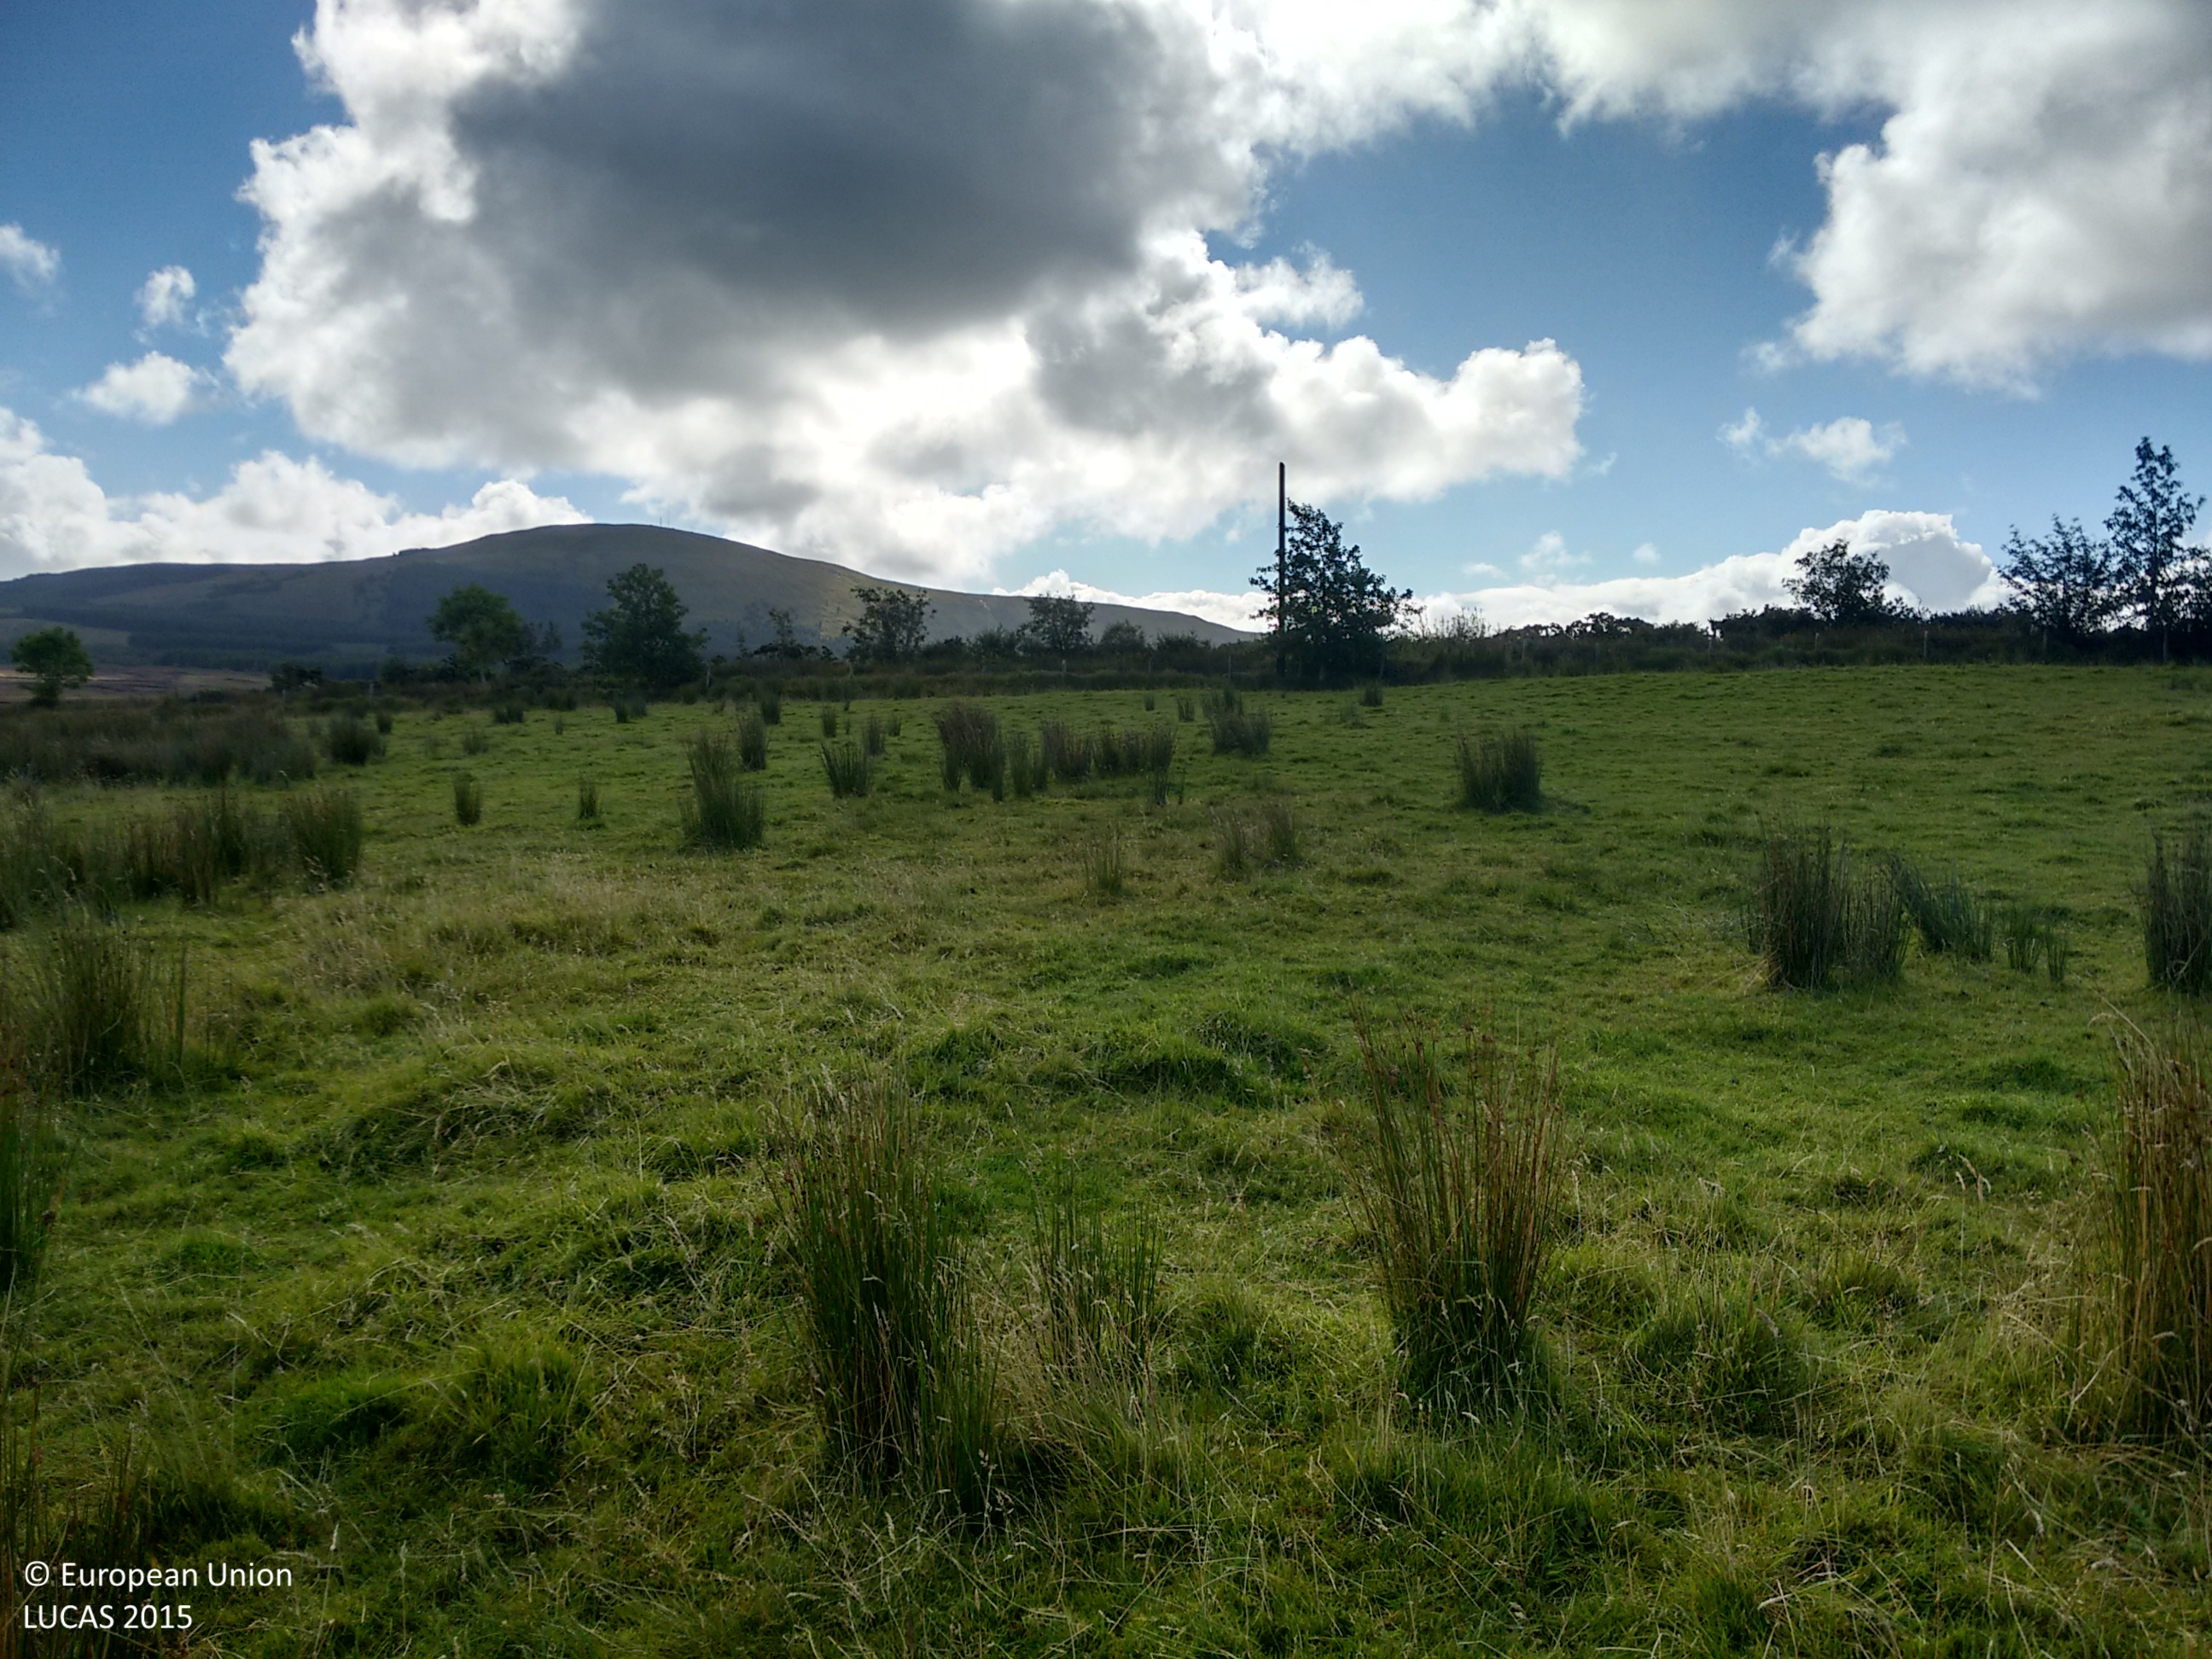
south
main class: Grassland
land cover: Grassland without tree/shrub cover
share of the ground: > 75 %
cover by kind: herbaceous plants 100 %
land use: Agriculture (excluding fallow land and kitchen gardens)
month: September
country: IE
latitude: 55.1165
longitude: -7.3803
